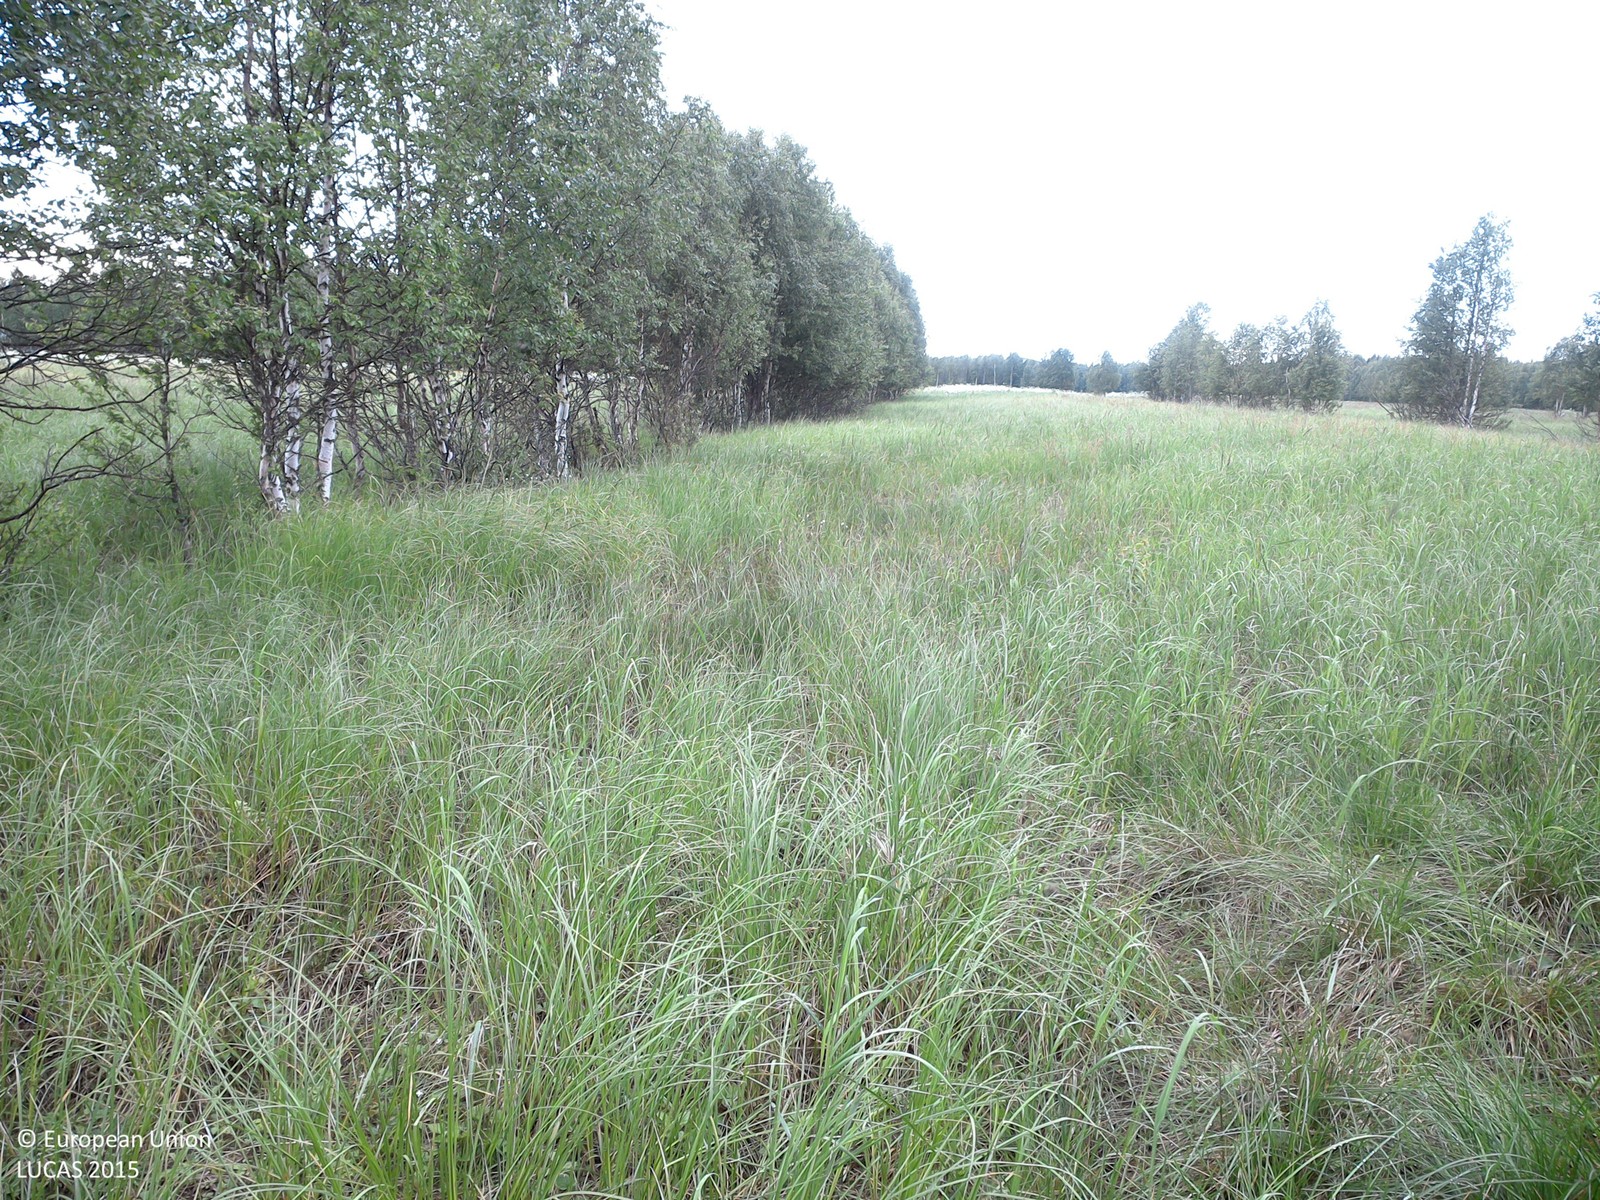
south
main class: Grassland
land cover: Grassland without tree/shrub cover
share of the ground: > 75 %
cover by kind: herbaceous plants 100 %
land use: Agriculture (excluding fallow land and kitchen gardens)
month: July
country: SE
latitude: 66.9155
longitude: 23.6707
